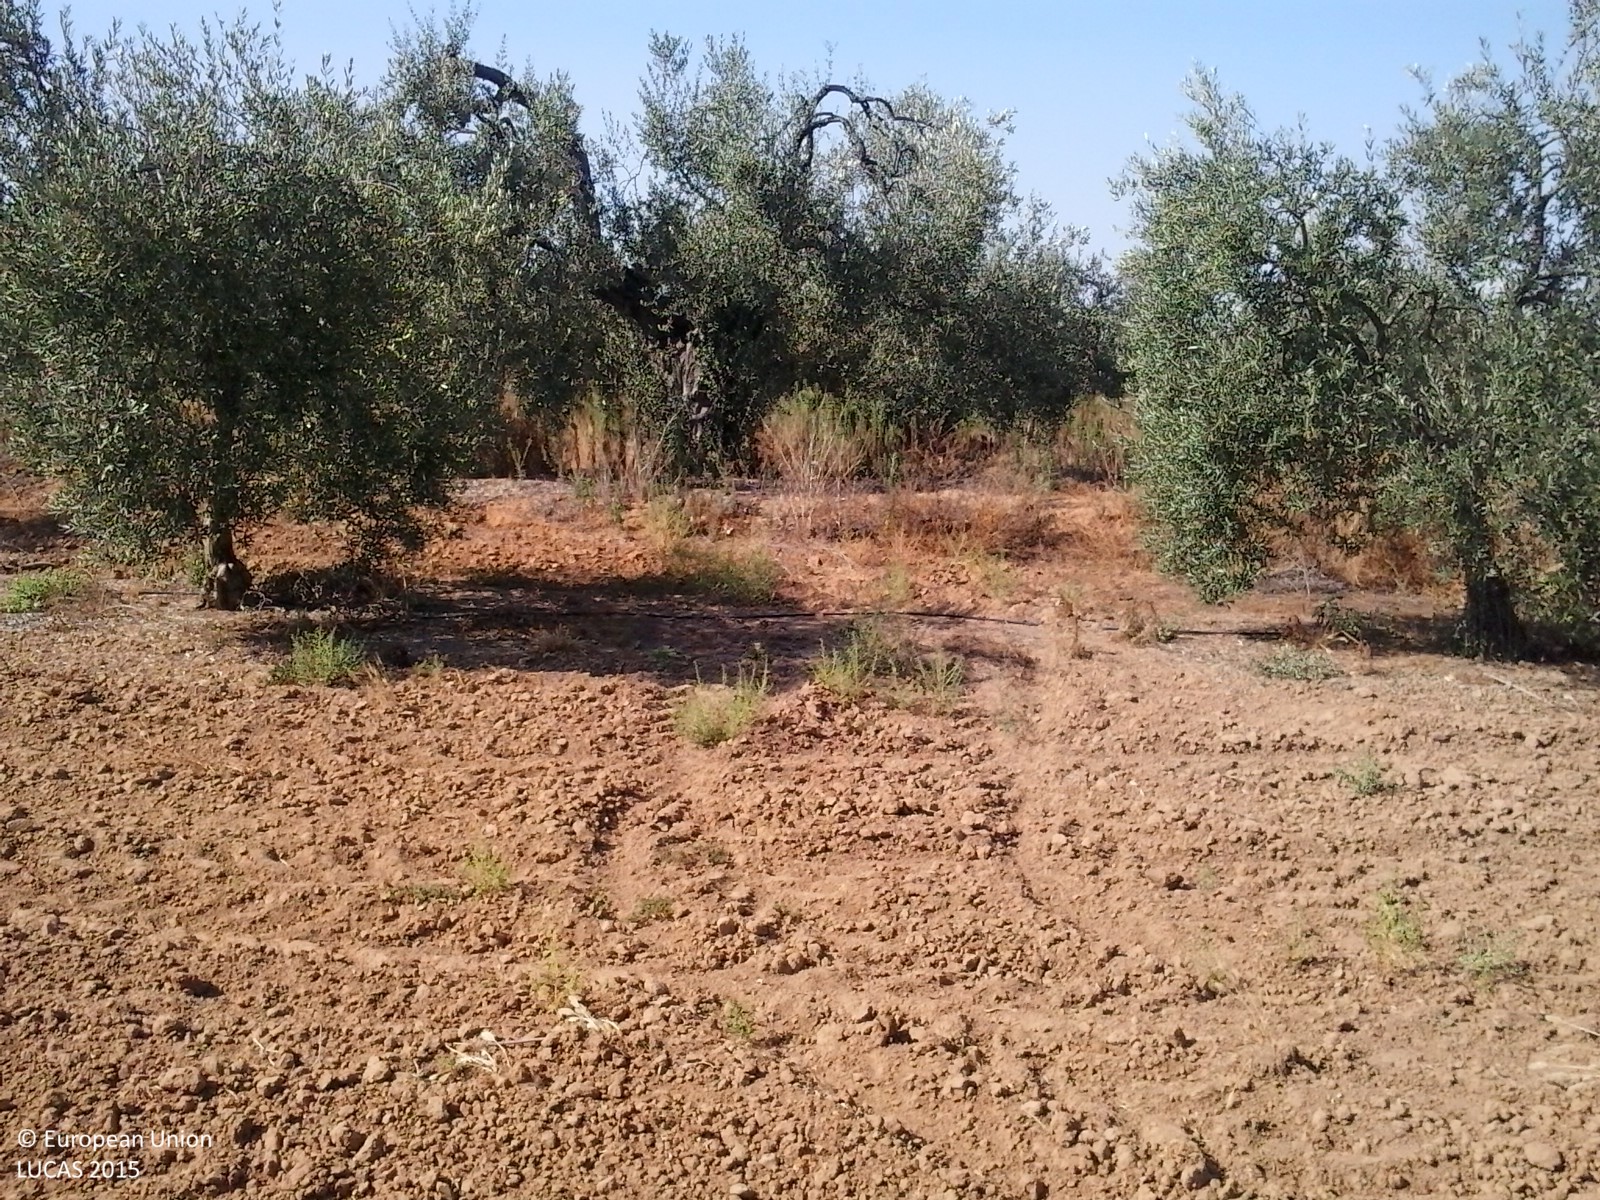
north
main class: Cropland
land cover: Olive groves
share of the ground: 25 - 50 %
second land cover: Other bare soil
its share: > 75 %
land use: Agriculture (excluding fallow land and kitchen gardens)
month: June
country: ES
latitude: 37.3627
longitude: -6.4135
